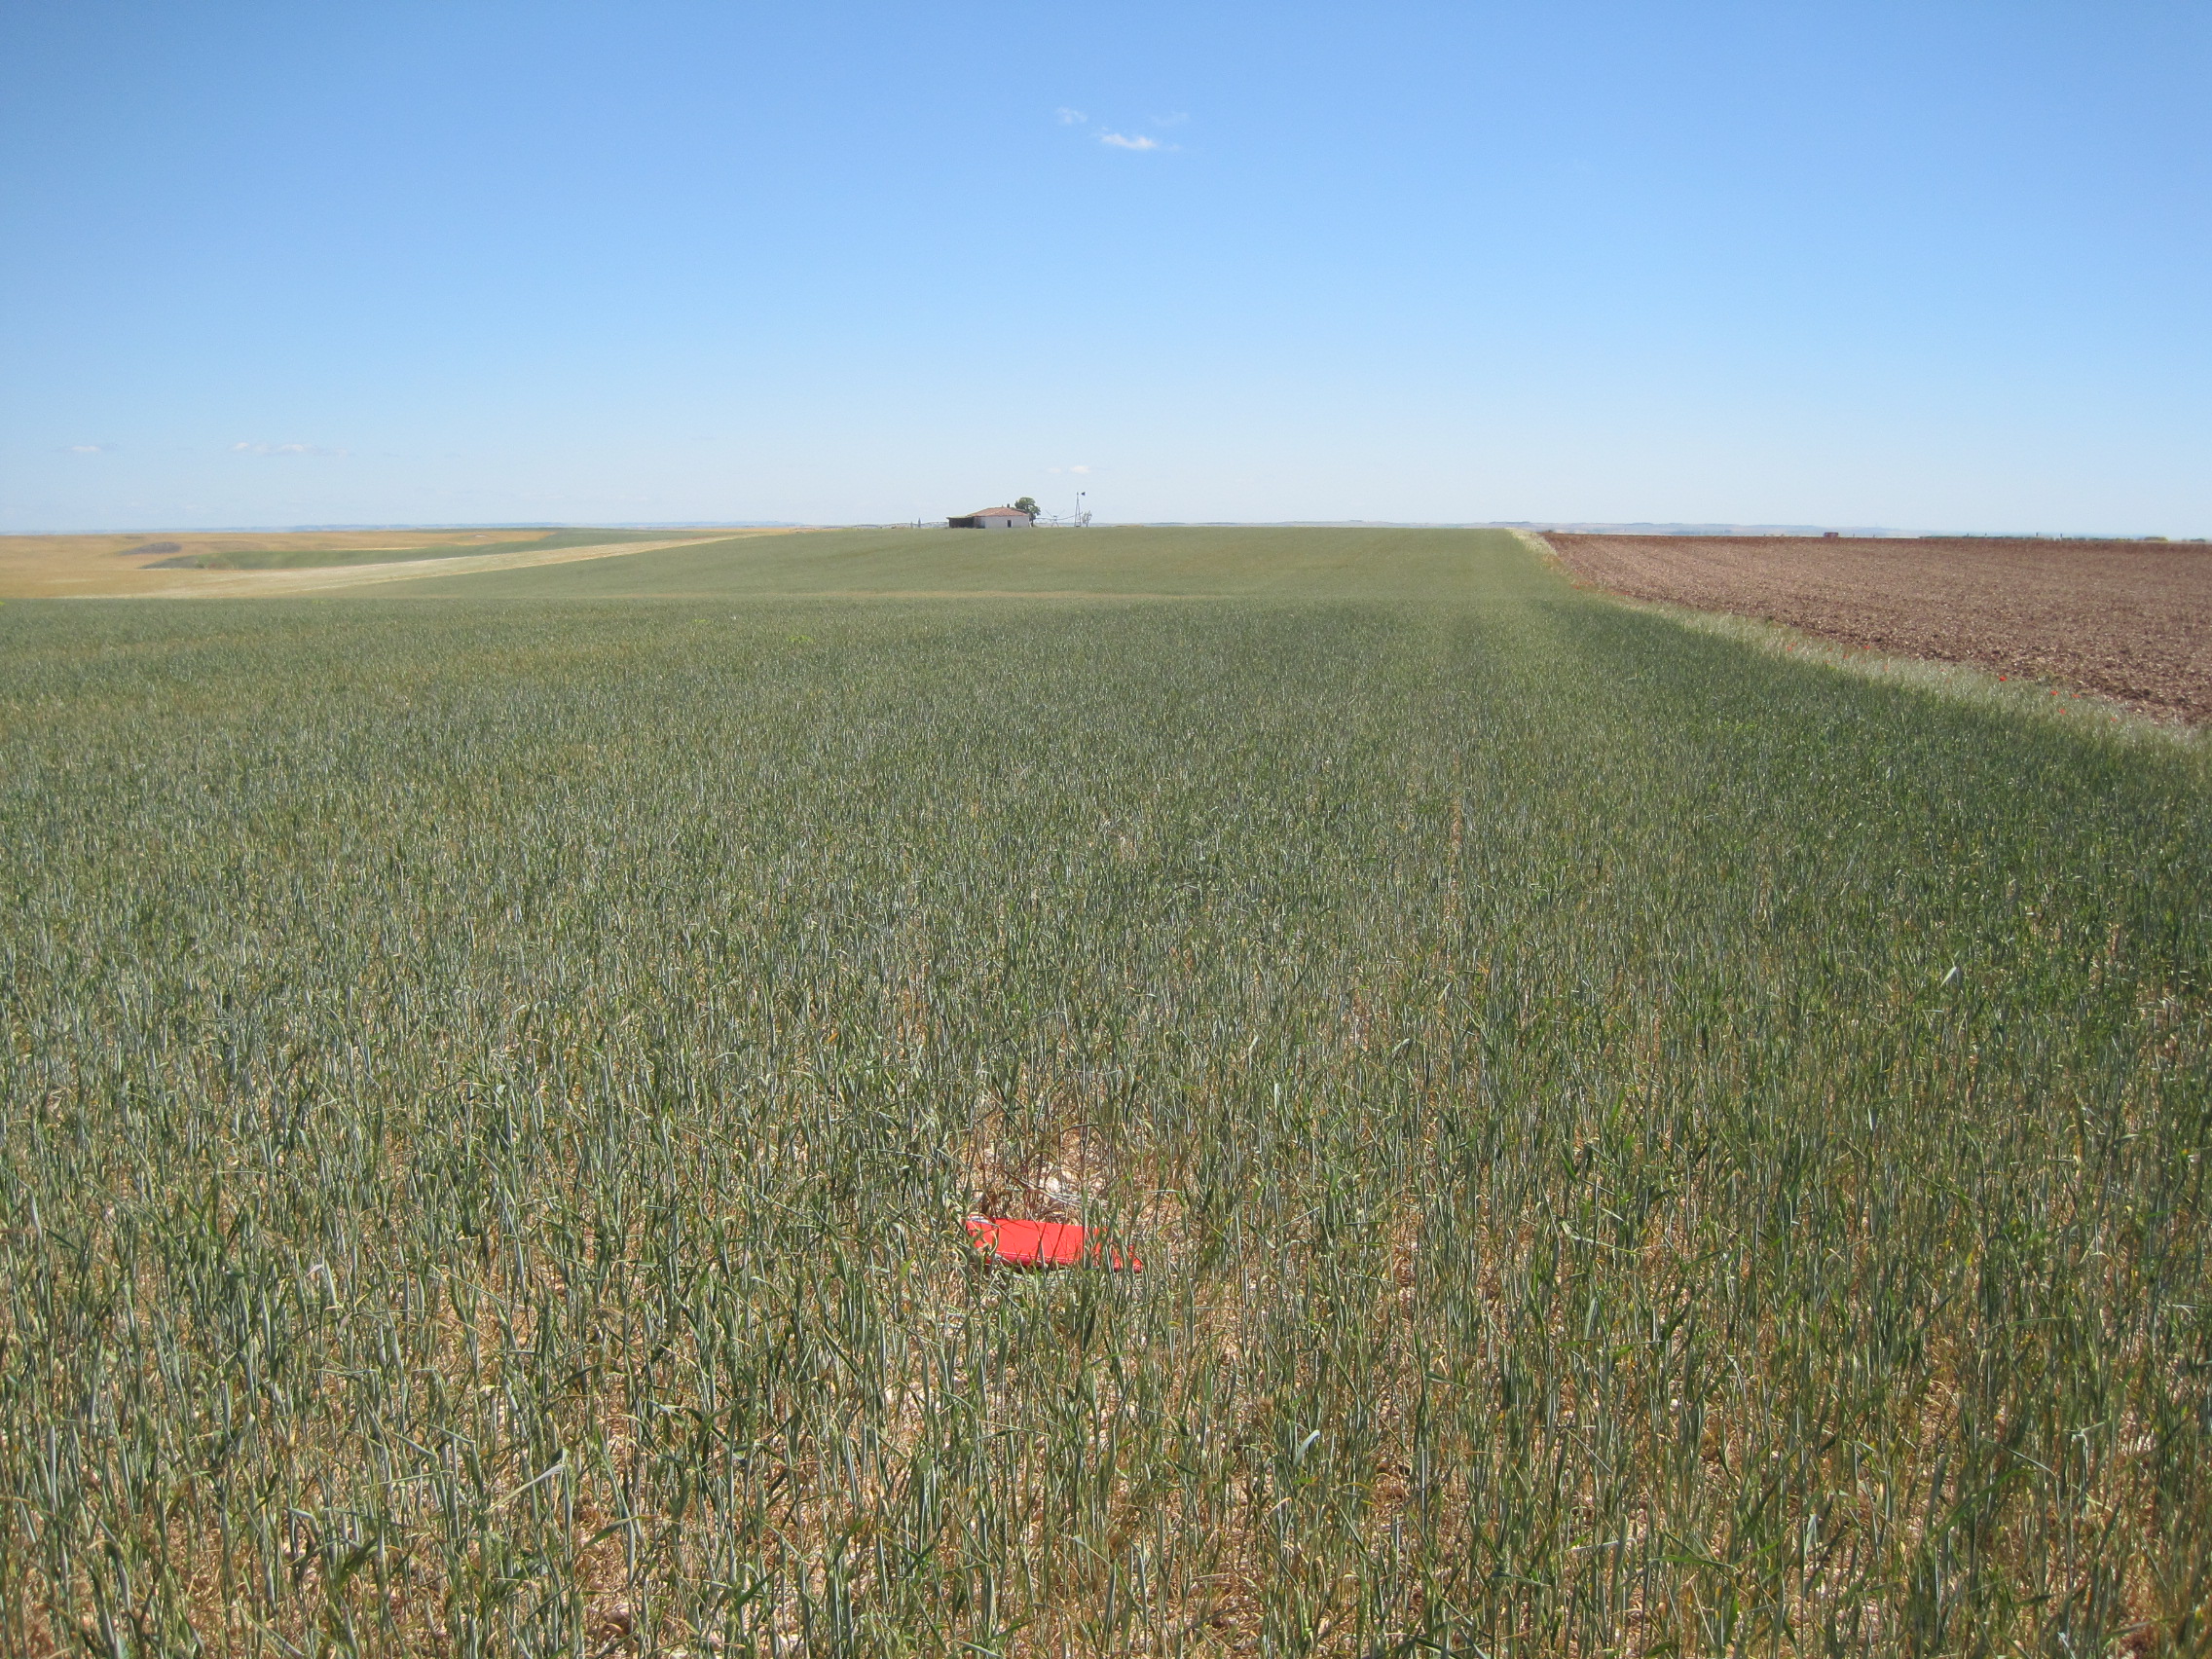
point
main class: Cropland
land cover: Common wheat
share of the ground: > 75 %
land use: Agriculture (excluding fallow land and kitchen gardens)
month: May
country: ES
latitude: 41.2432
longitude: -5.3121
